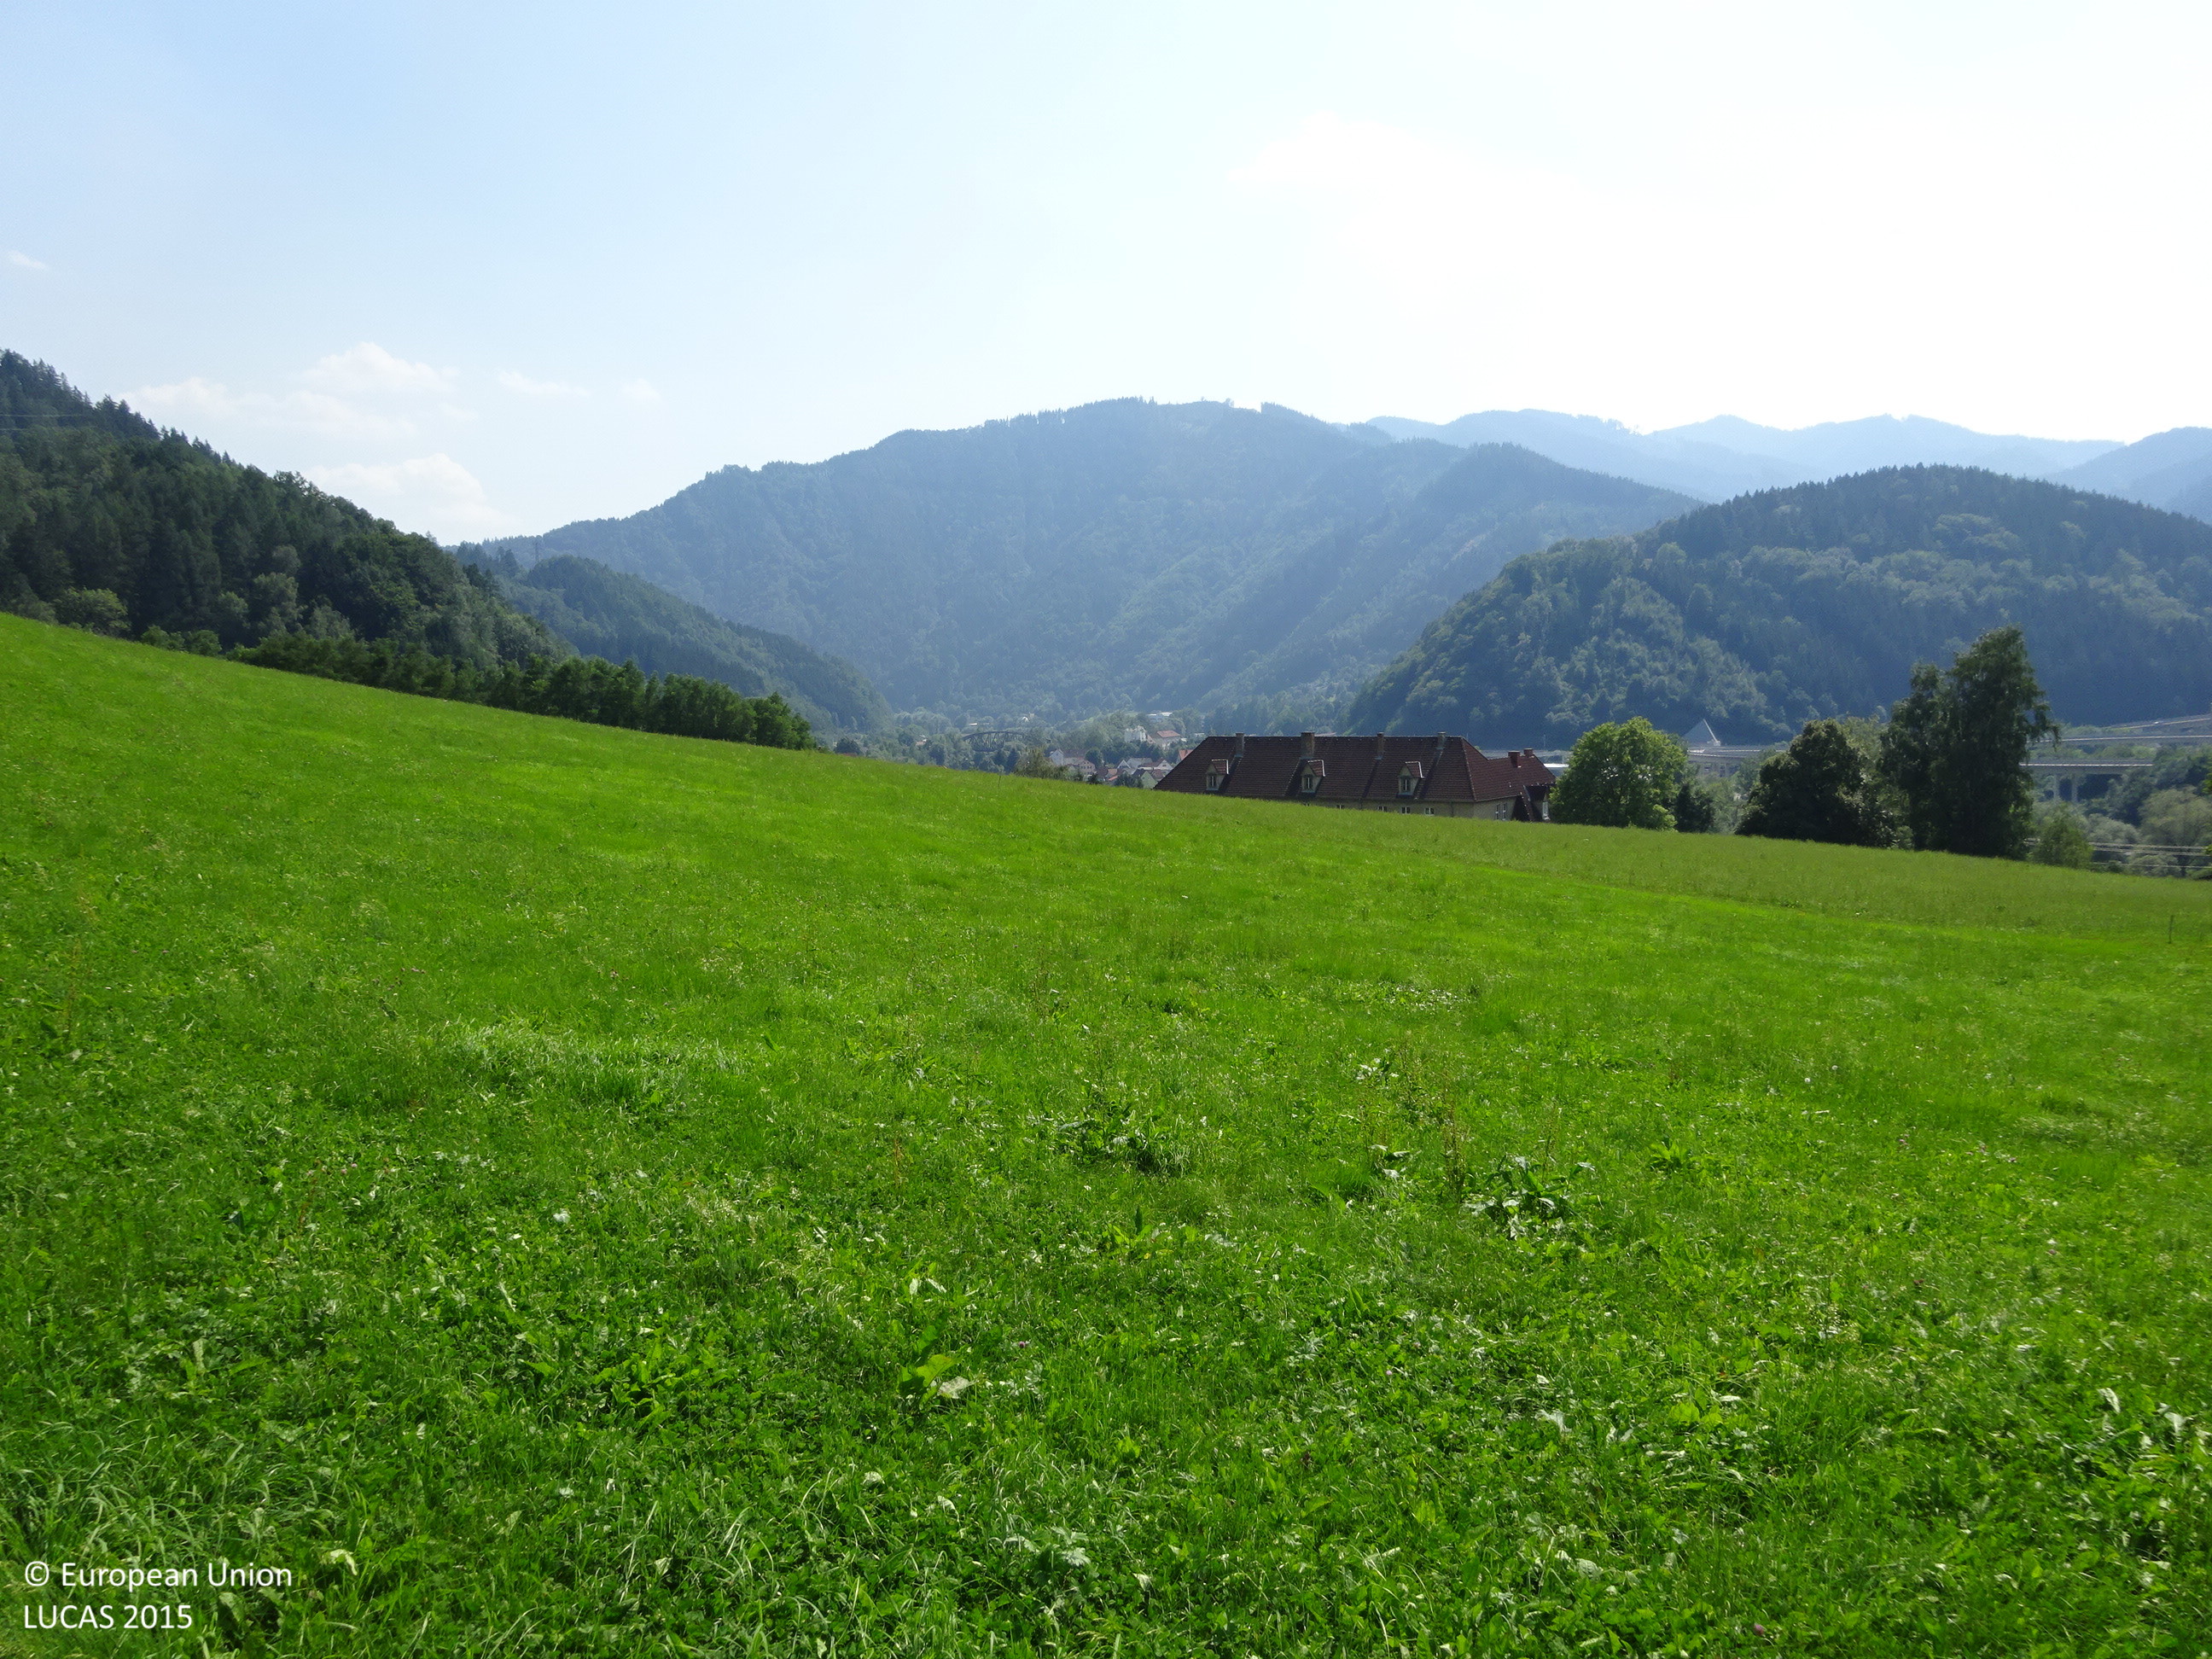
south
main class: Grassland
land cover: Grassland without tree/shrub cover
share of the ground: > 75 %
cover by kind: herbaceous plants 100 %
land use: Agriculture (excluding fallow land and kitchen gardens)
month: August
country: AT
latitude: 47.4113
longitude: 15.2882
